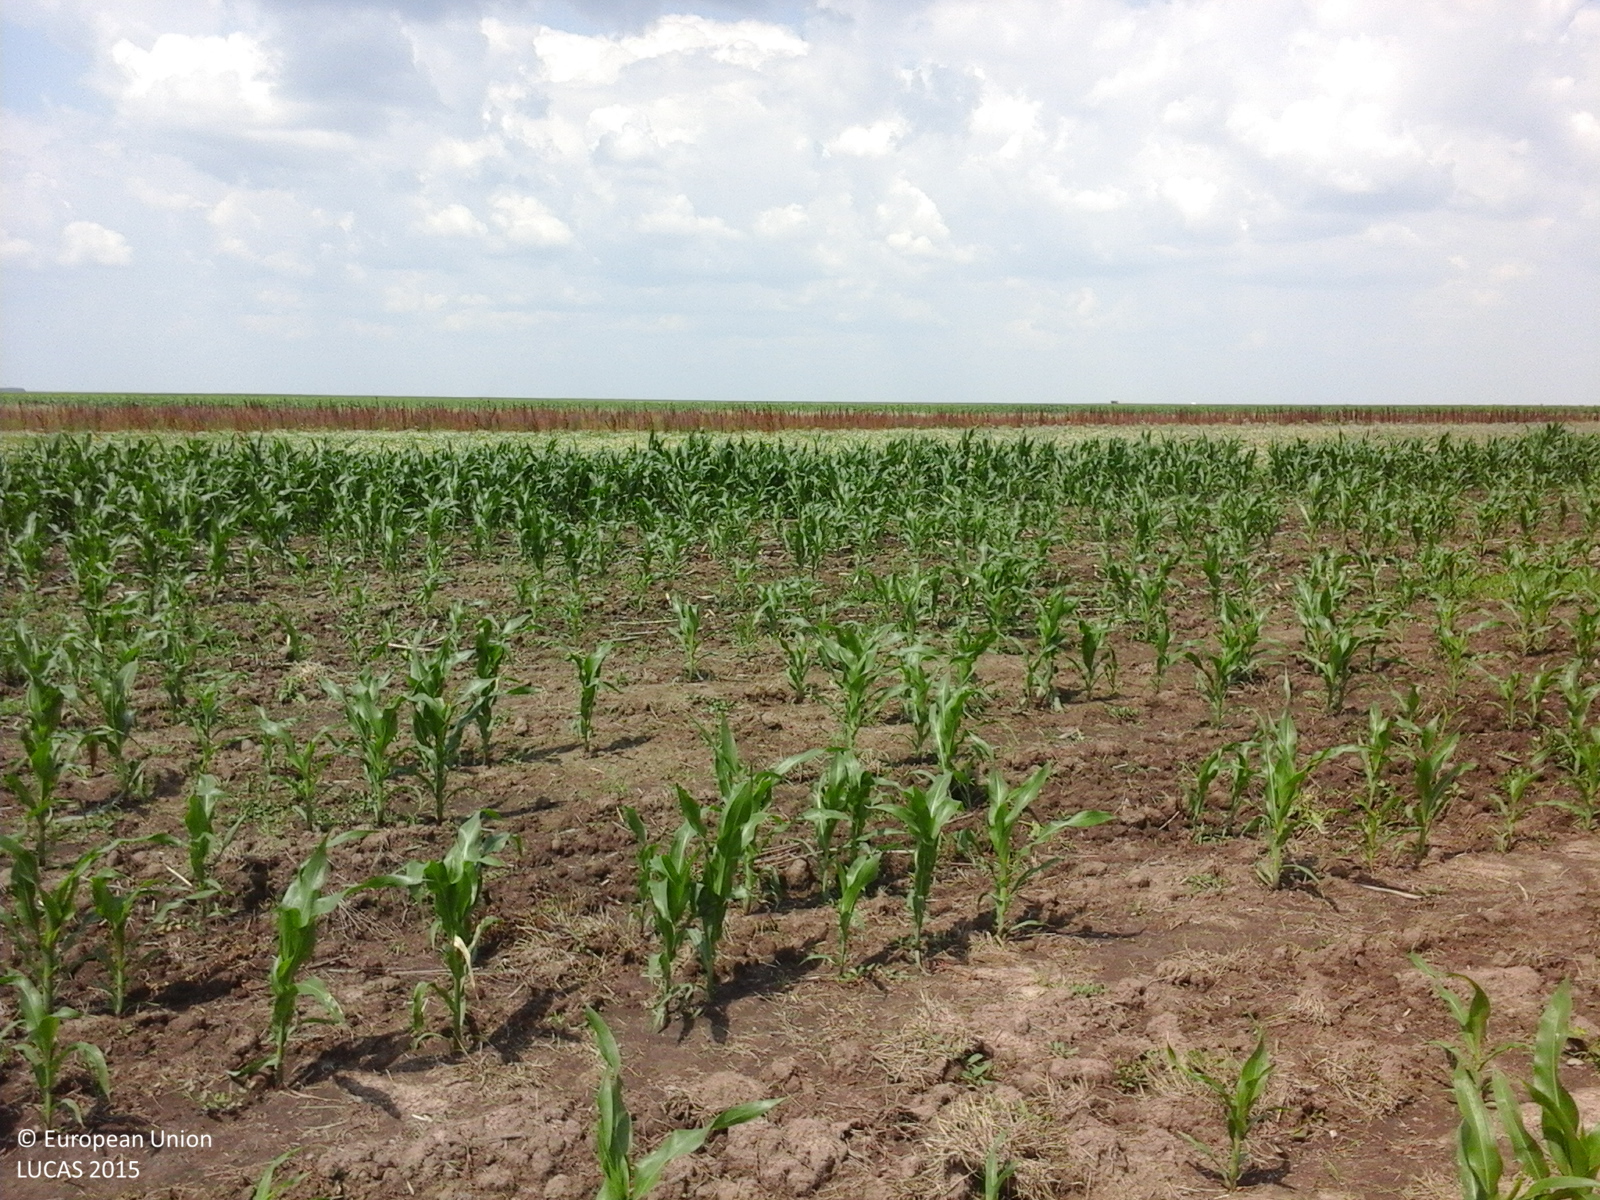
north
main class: Cropland
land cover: Maize
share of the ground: 25 - 50 %
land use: Agriculture (excluding fallow land and kitchen gardens)
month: July
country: RO
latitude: 44.0339
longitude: 25.2934
